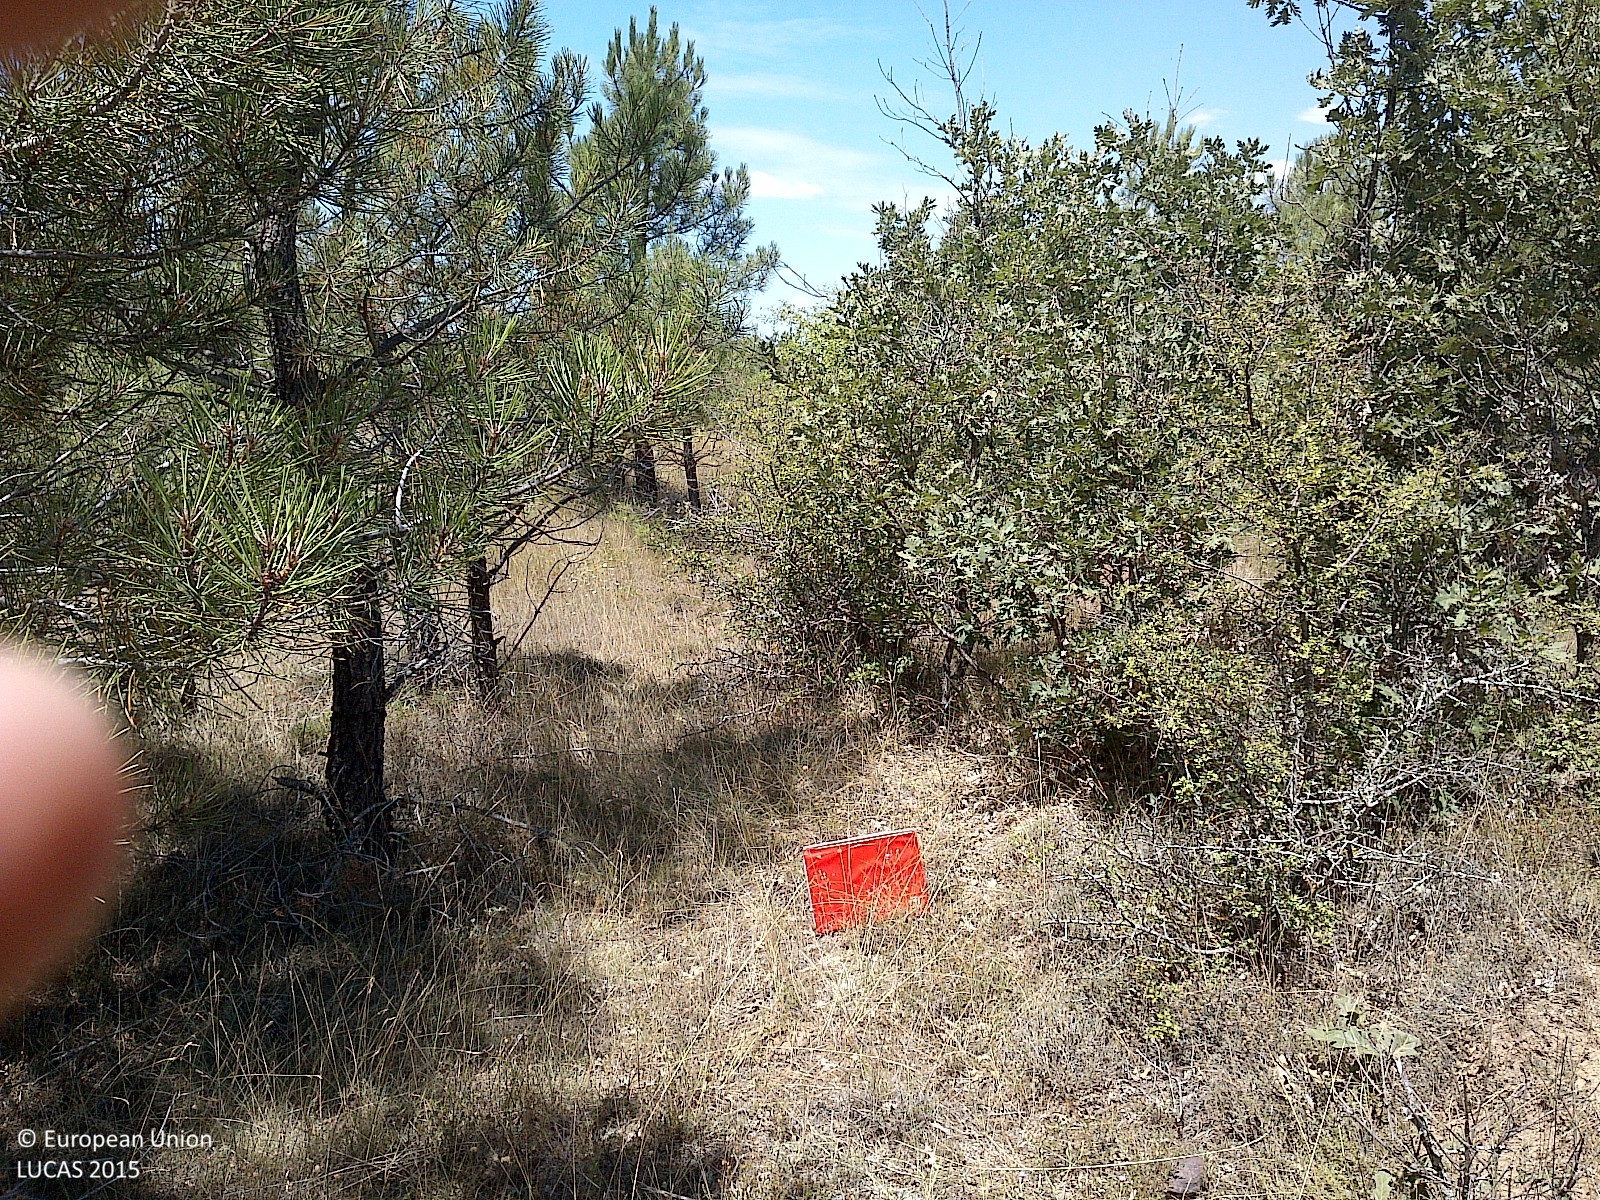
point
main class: Woodland
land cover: Pine dominated mixed woodland
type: coniferous forest of the mediterranean region
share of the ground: 50 - 75 %
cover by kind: coniferous forest trees 50 %, herbaceous plants 25 %, broadleaved forest trees 20 %, unconsolidated bare surface 5 %
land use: Forestry
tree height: < 5 m
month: July
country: ES
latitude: 41.6963
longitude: -2.0364
